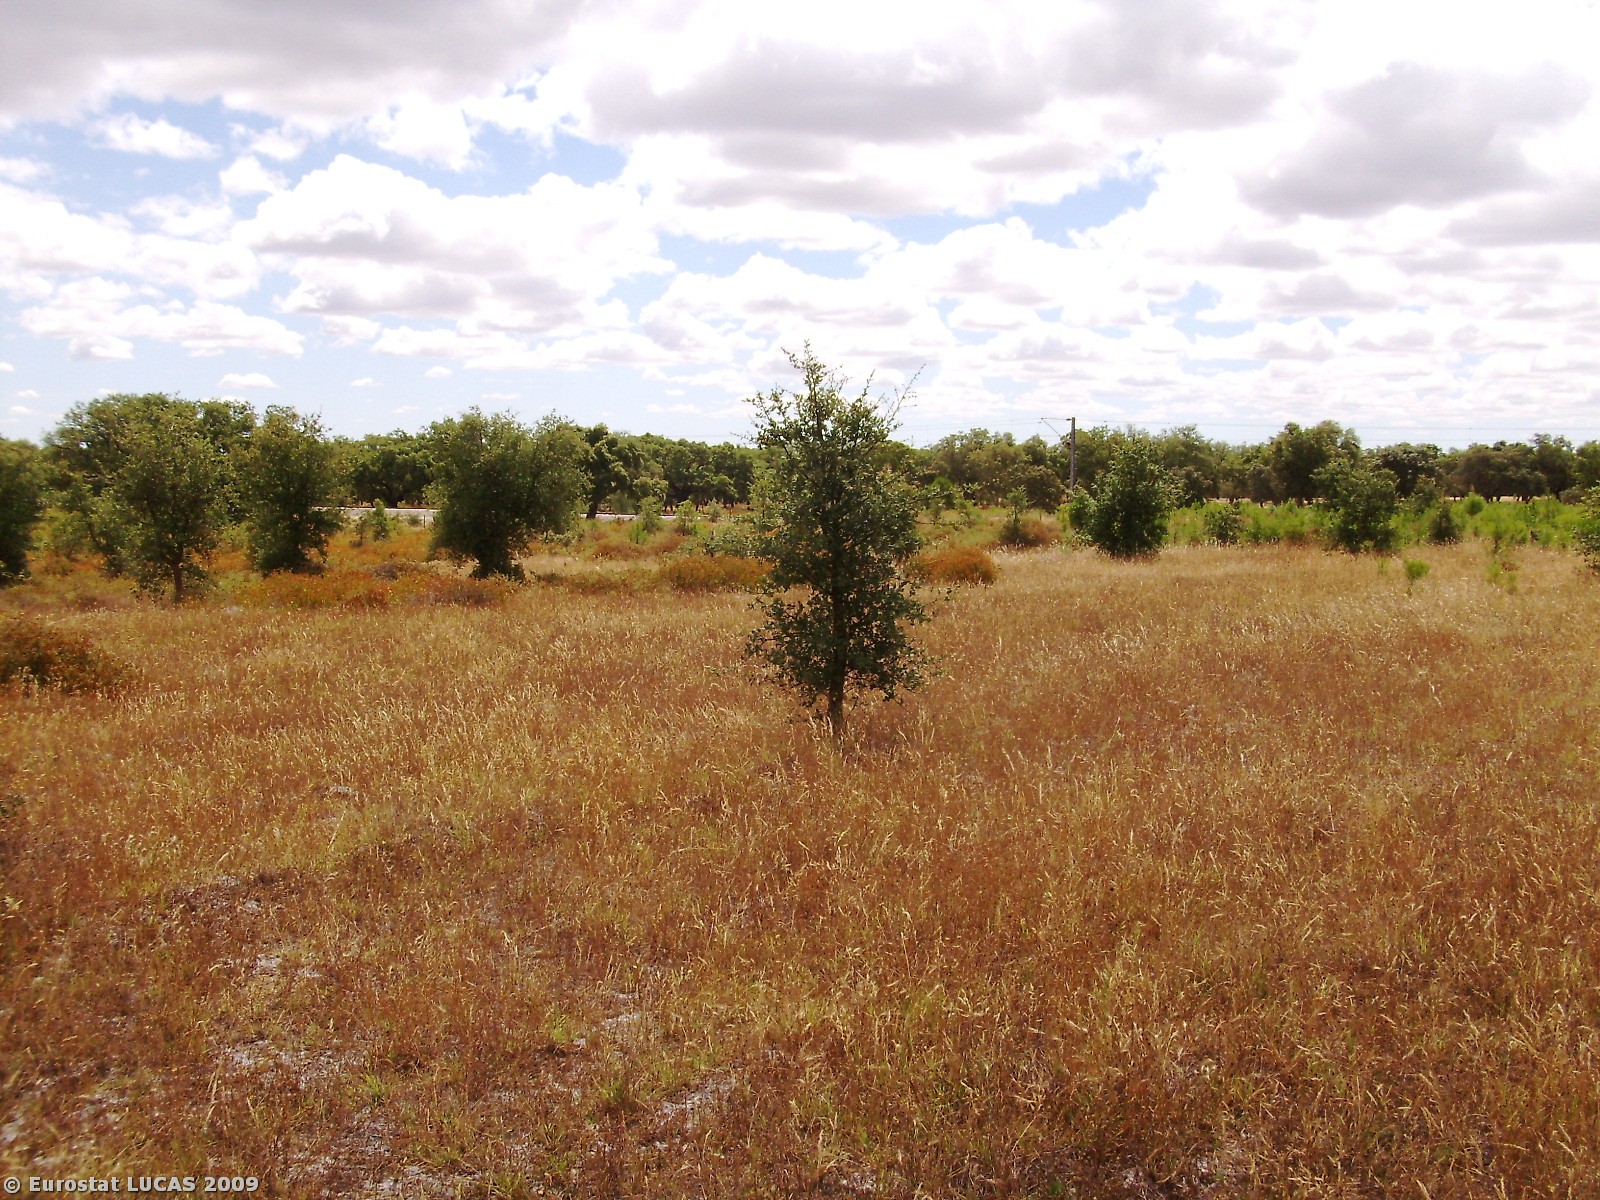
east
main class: Woodland
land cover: Broadleaved woodland
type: broadleaved evergreen forest
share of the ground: 10 - 25 %
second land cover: Spontaneously vegetated surfaces
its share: > 75 %
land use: Forestry
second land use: Fallow land
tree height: > 5 m
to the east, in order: Broadleaved woodland; Spontaneously vegetated surfaces; Broadleaved woodland; Shrubland with sparse tree cover; Fences; Bare land; Railways; Shrubland with sparse tree cover; Fences; Broadleaved woodland
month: June
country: PT
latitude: 37.9817
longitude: -8.4511
